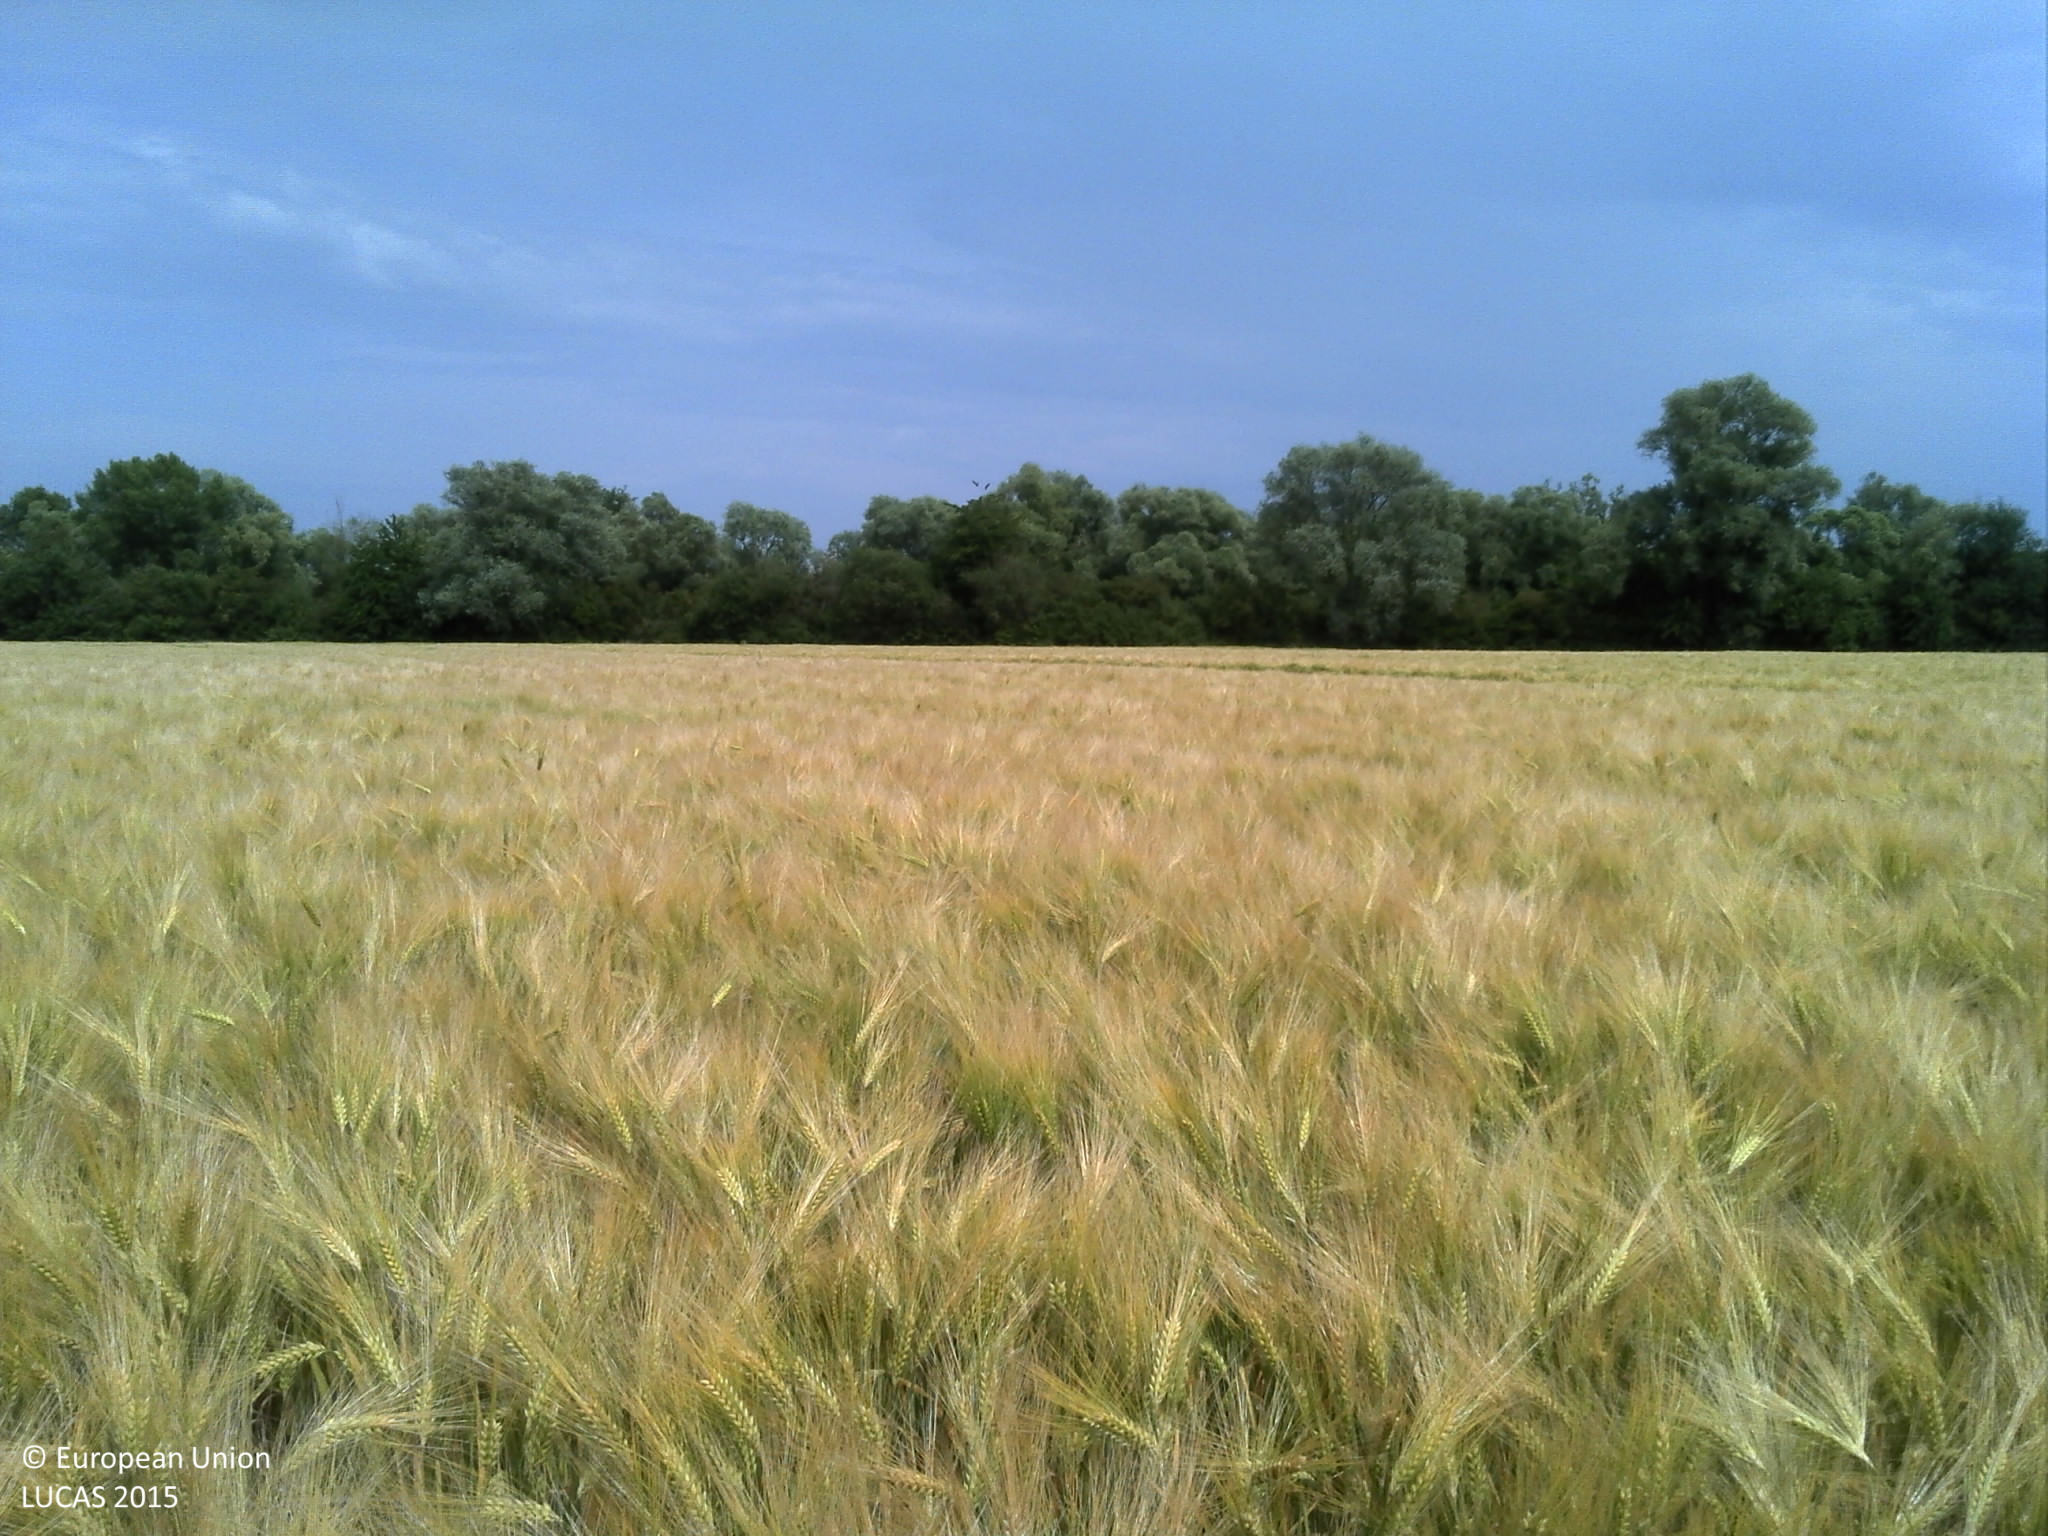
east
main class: Cropland
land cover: Barley
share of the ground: > 75 %
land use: Agriculture (excluding fallow land and kitchen gardens)
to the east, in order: Barley; Grass margins; Groves; Grass margins; Paved roads, cycling and walking lanes; Grass margins; Grassland with sparse tree/shrub cover; Broadleaved woodland; Inland fresh running water
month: June
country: FR
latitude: 49.1667
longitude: 6.2007
